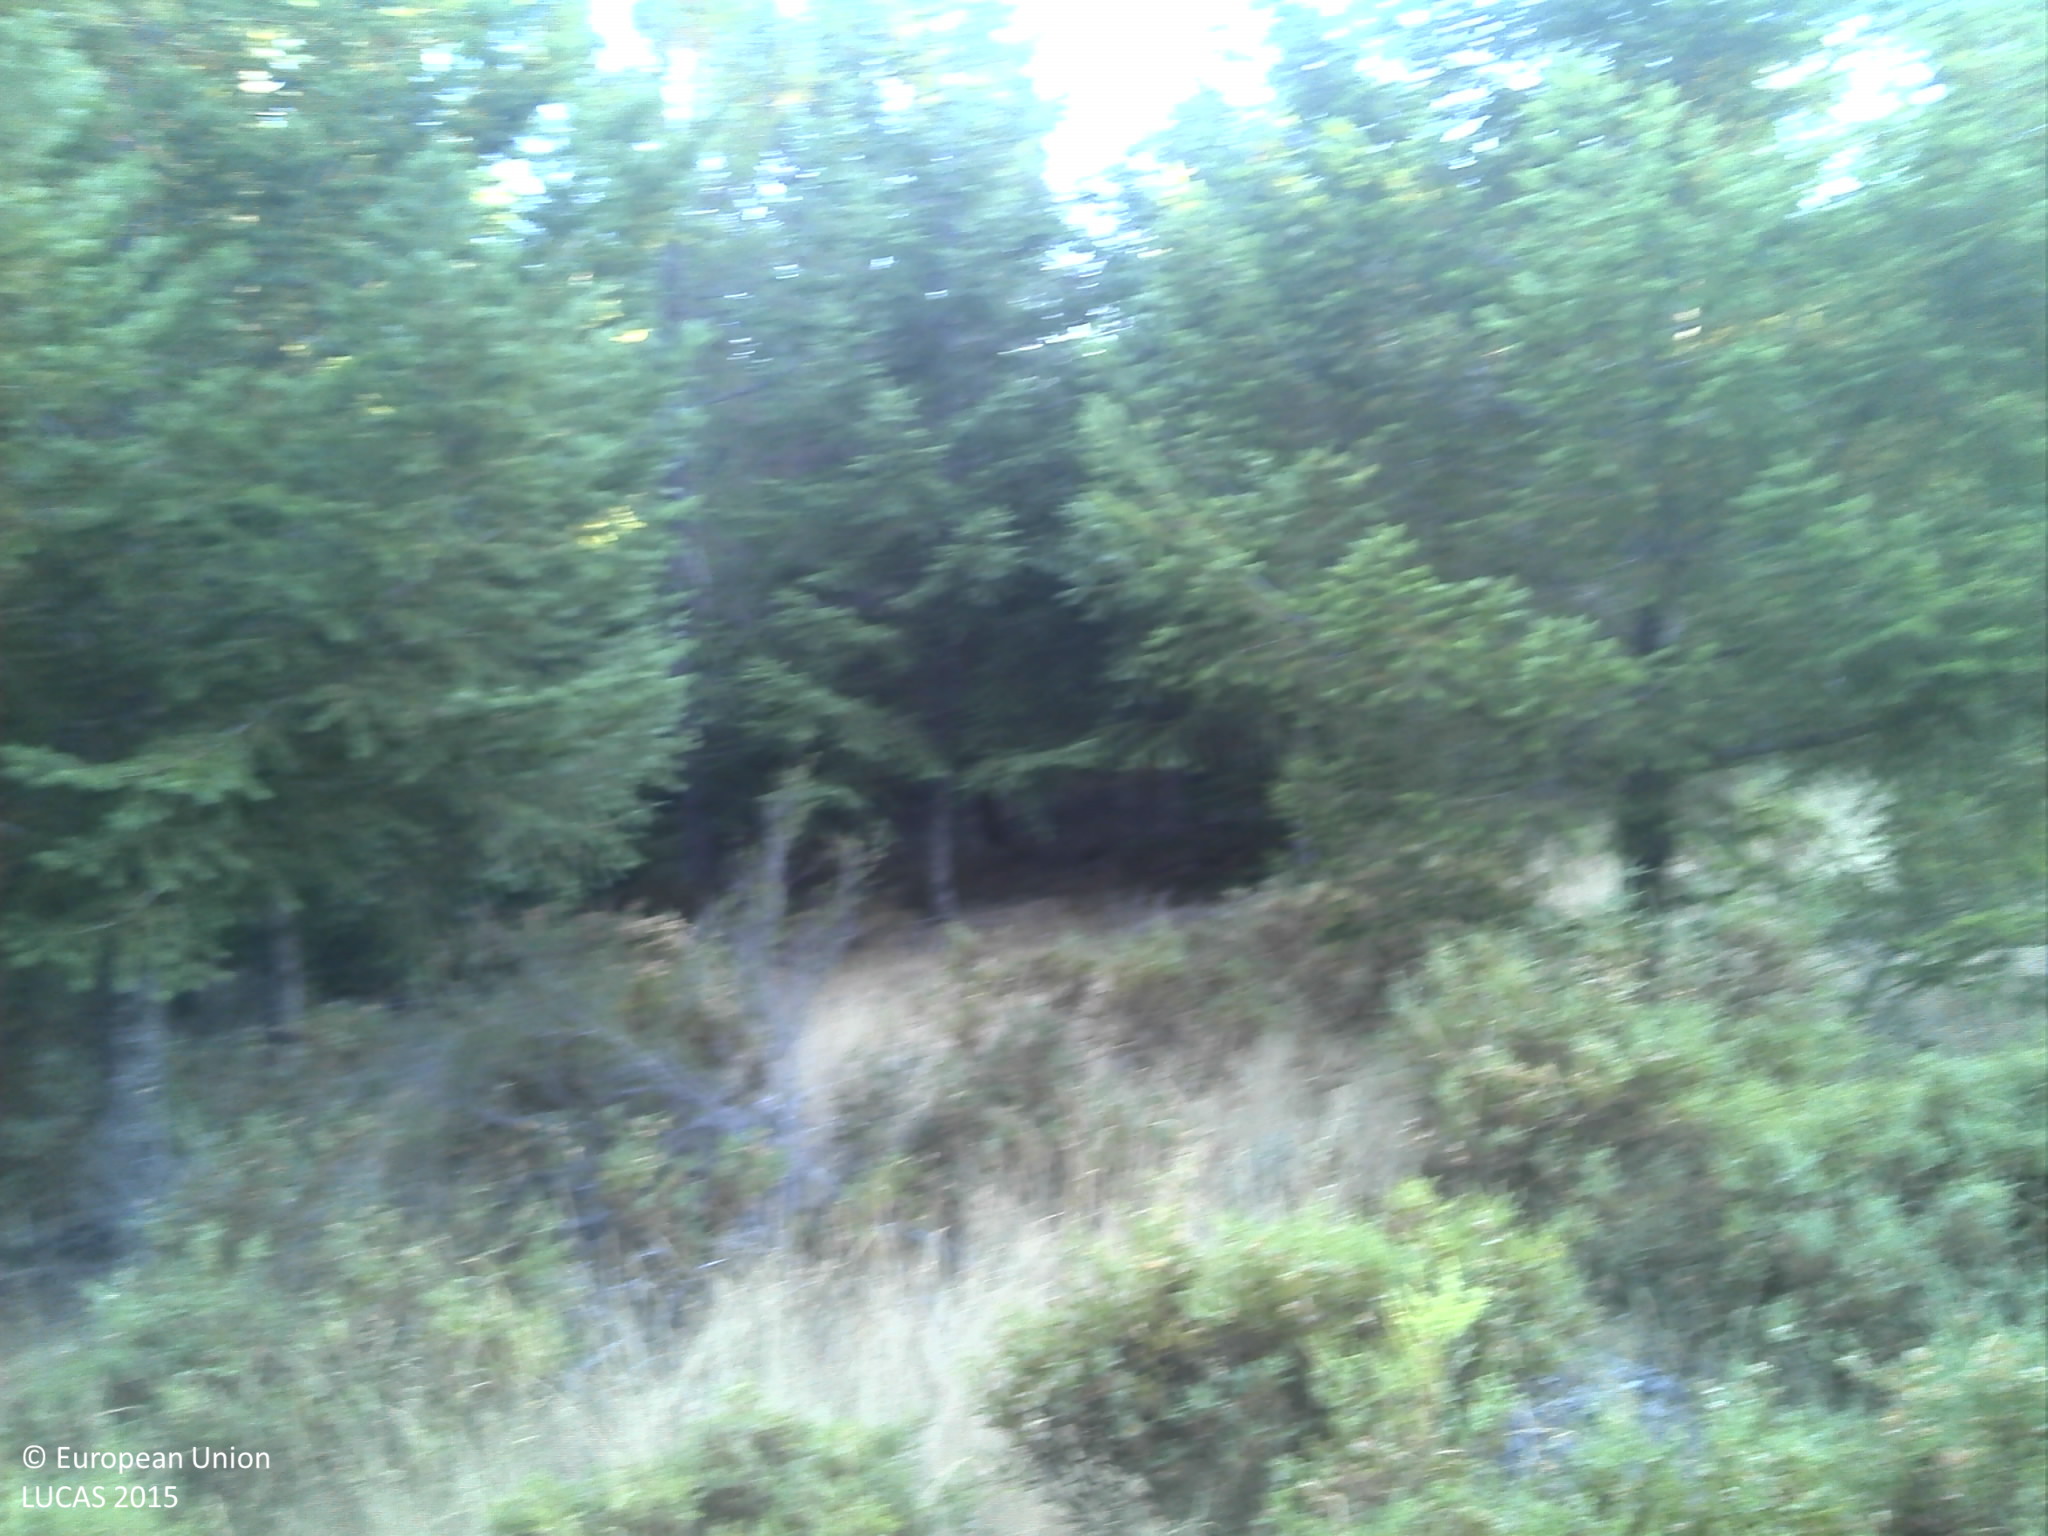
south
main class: Woodland
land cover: Pine dominated coniferous woodland
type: coniferous forest of the mediterranean region
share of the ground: 50 - 75 %
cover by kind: coniferous forest trees 60 %, shrubs 15 %, unconsolidated bare surface 15 %
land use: Forestry
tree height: > 5 m
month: August
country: PT
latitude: 40.4427
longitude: -7.4515
